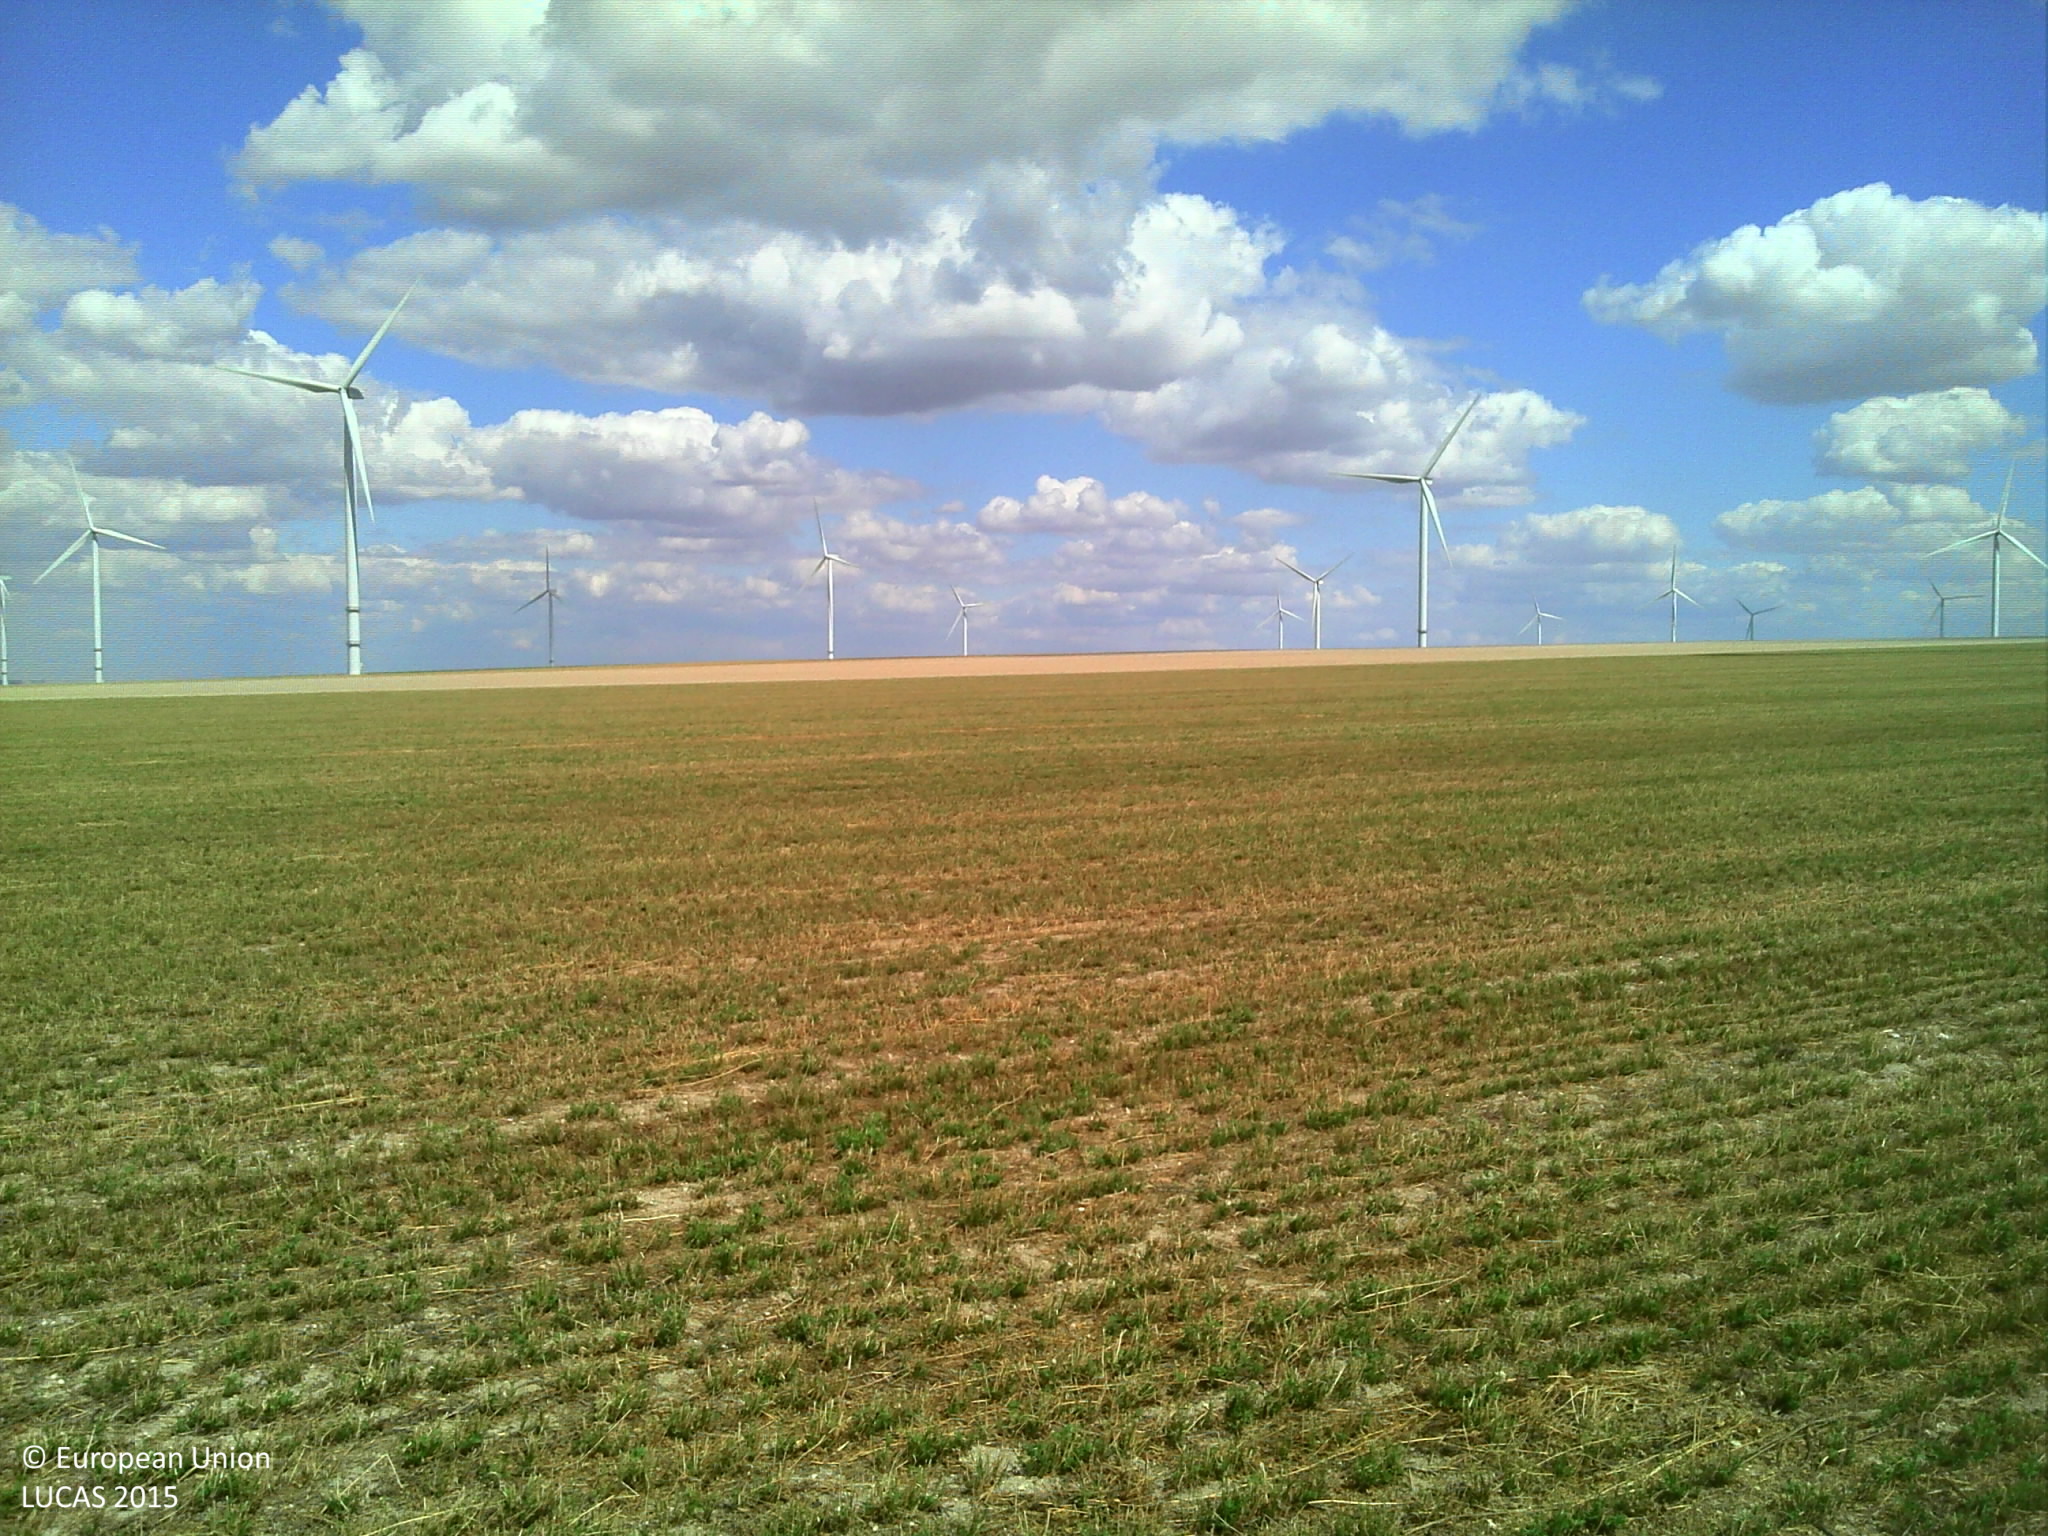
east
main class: Cropland
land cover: Lucerne
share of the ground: > 75 %
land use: Agriculture (excluding fallow land and kitchen gardens)
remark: Harvested field
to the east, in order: Lucerne; Other bare soil
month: July
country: FR
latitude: 48.8991
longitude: 4.1710
